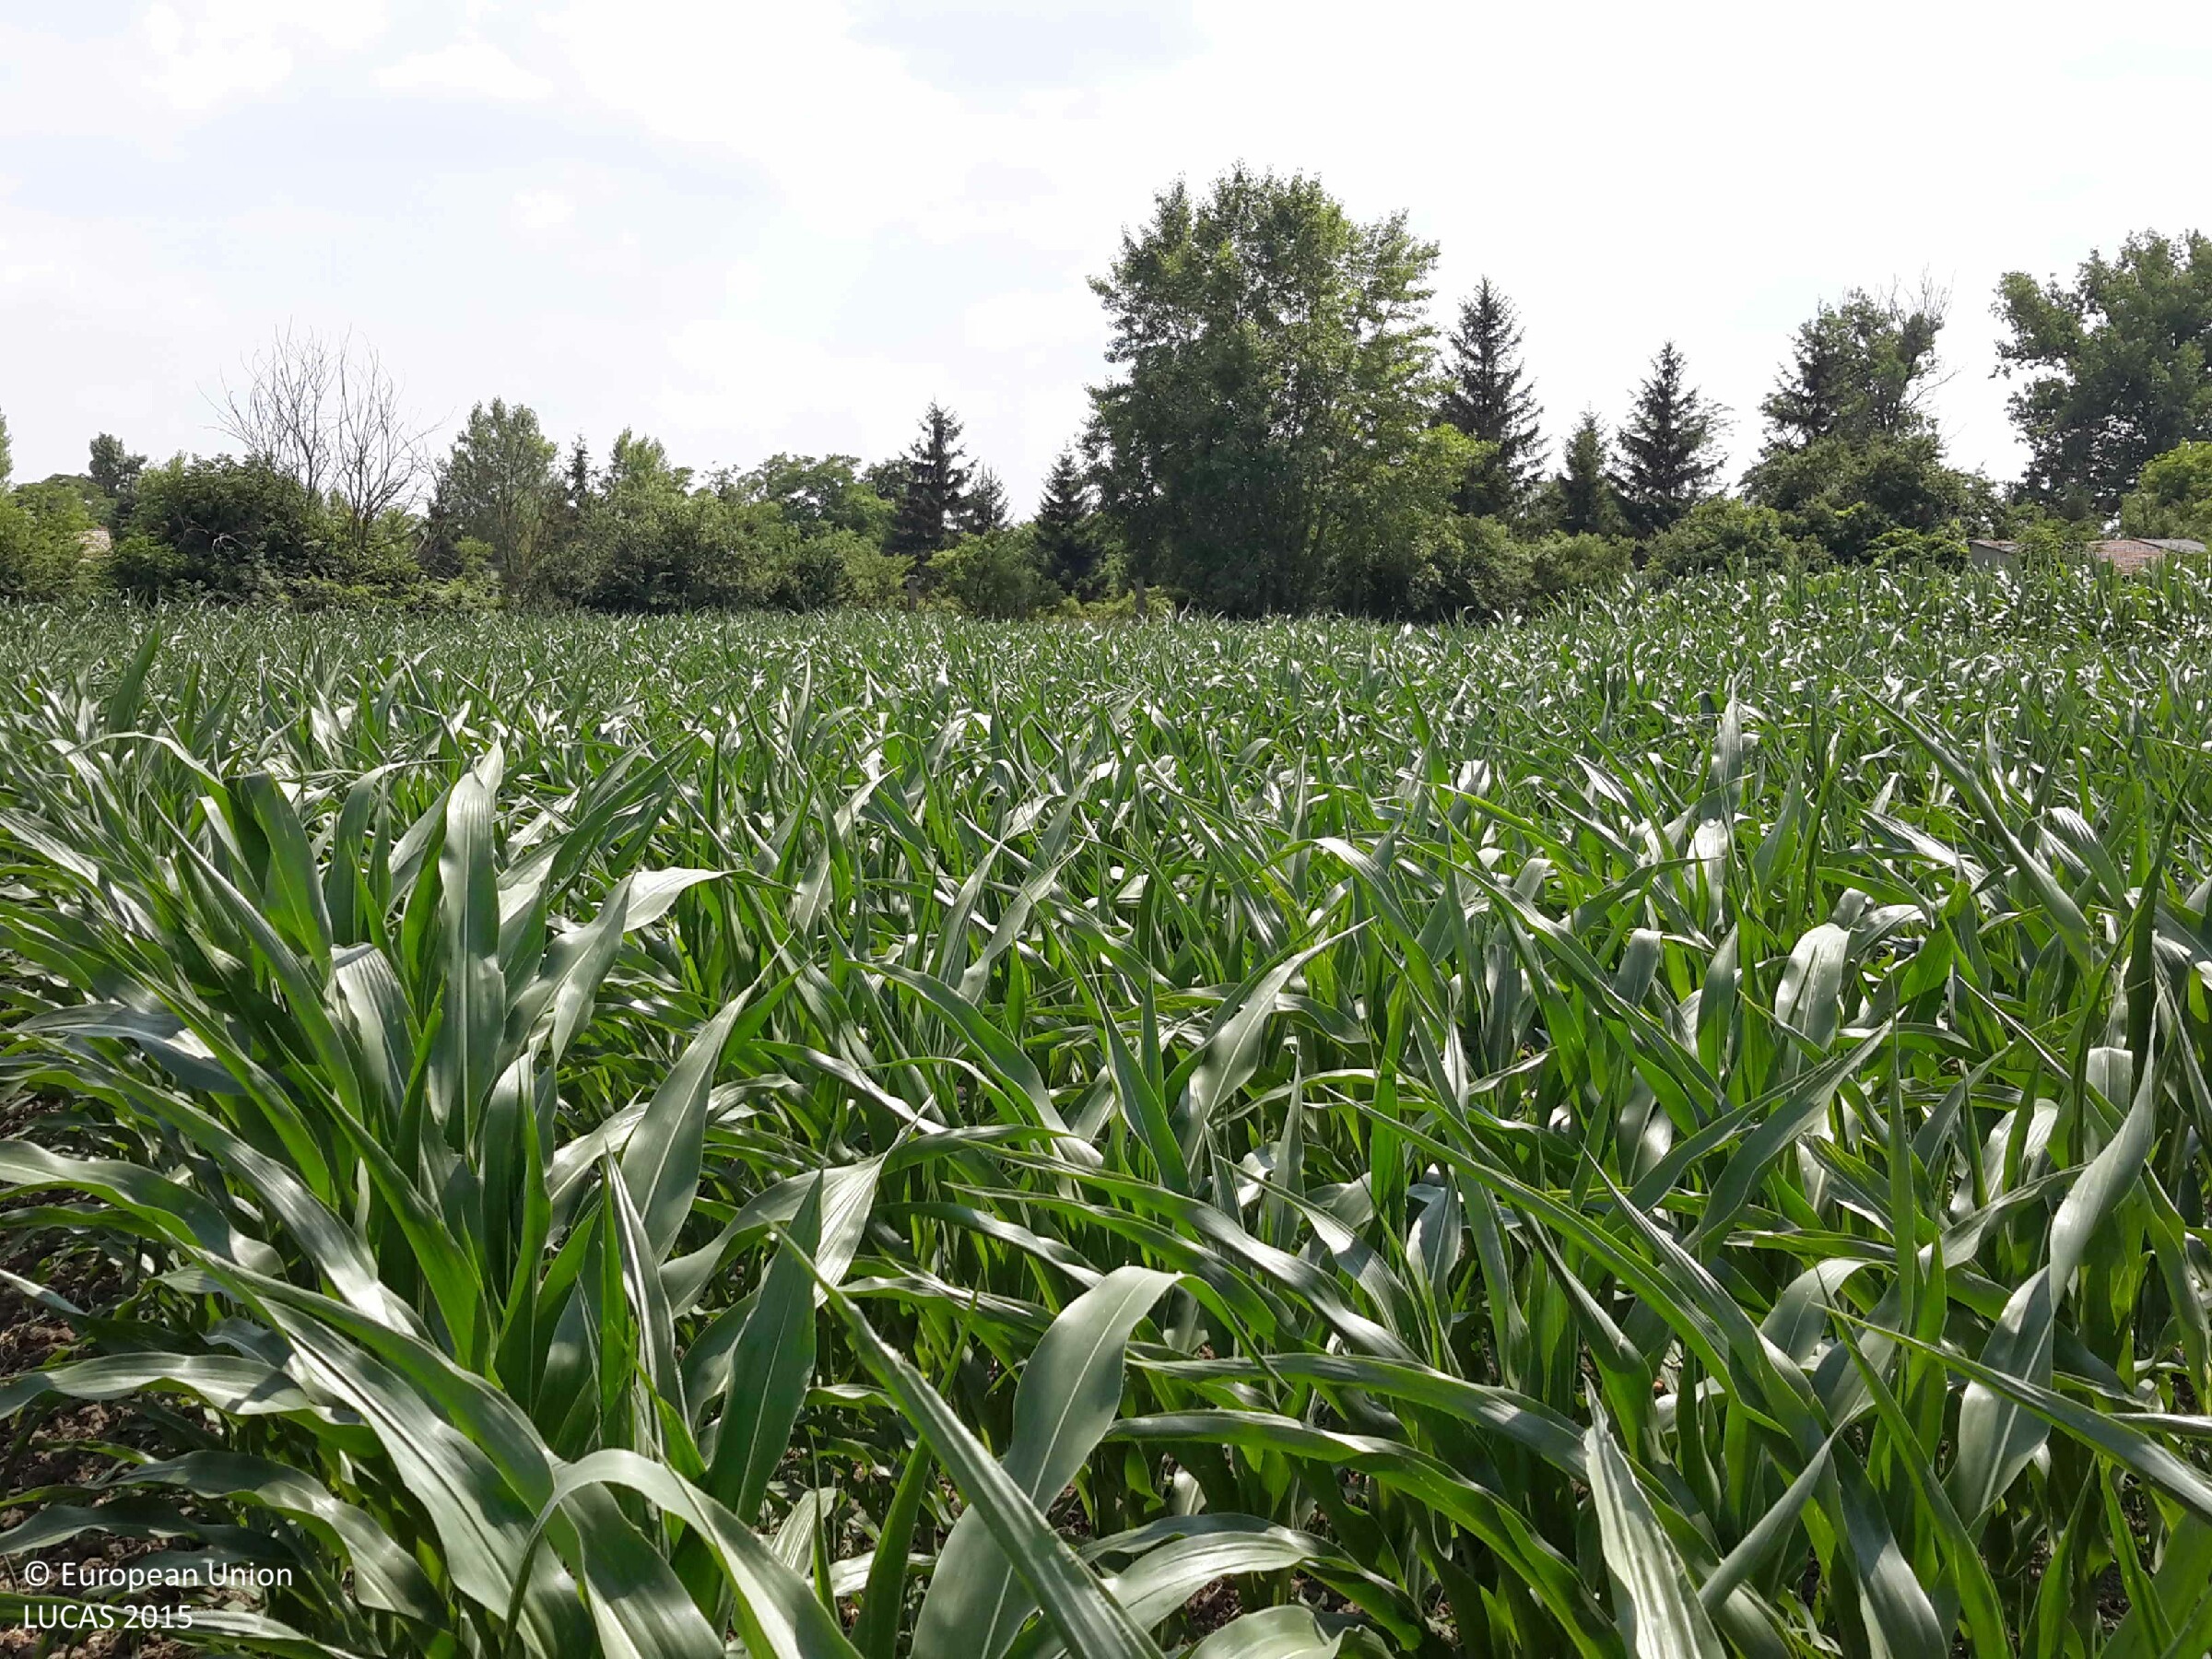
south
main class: Cropland
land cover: Maize
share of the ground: 50 - 75 %
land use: Agriculture (excluding fallow land and kitchen gardens)
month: July
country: HU
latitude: 47.3615
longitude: 17.3820
